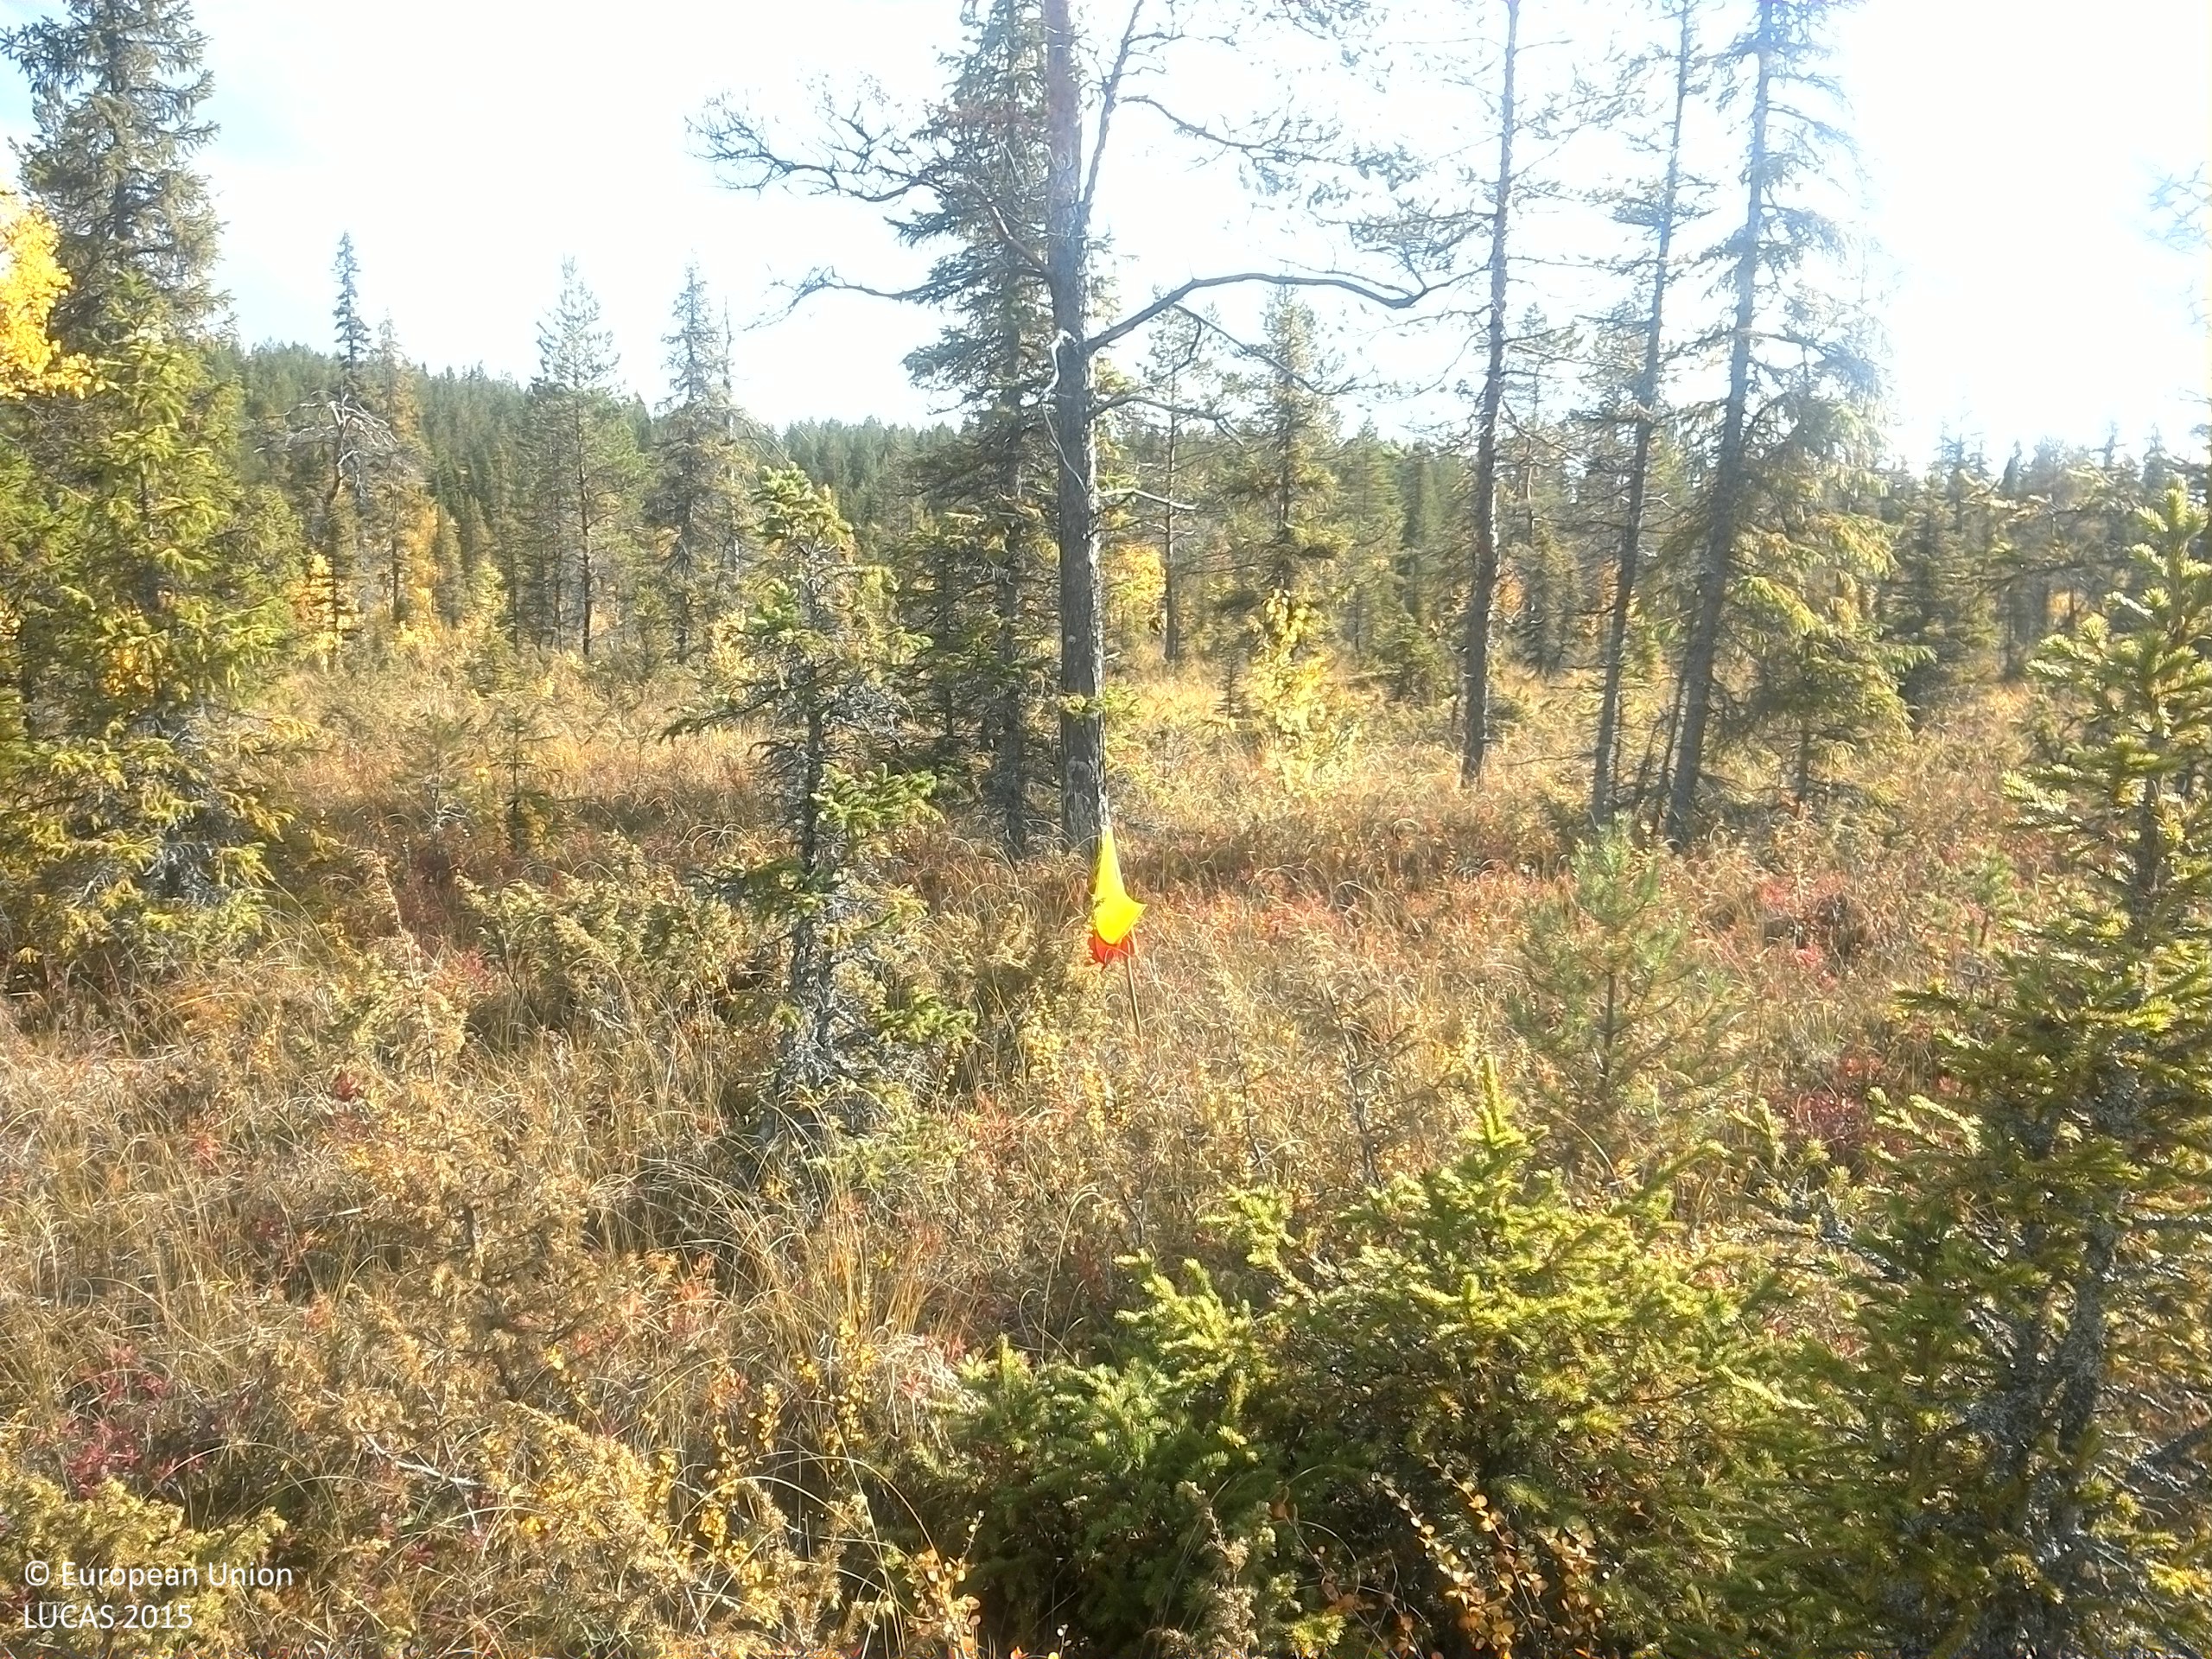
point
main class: Woodland
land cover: Spruce dominated mixed woodland
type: mire and swamp forests
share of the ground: 25 - 50 %
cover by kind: shrubs 50 %, lichens and mosses 20 %, coniferous forest trees 15 %, broadleaved forest trees 10 %, herbaceous plants 5 %
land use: Semi-natural and natural areas not in use
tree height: < 5 m
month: September
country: SE
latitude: 63.6011
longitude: 15.8805
